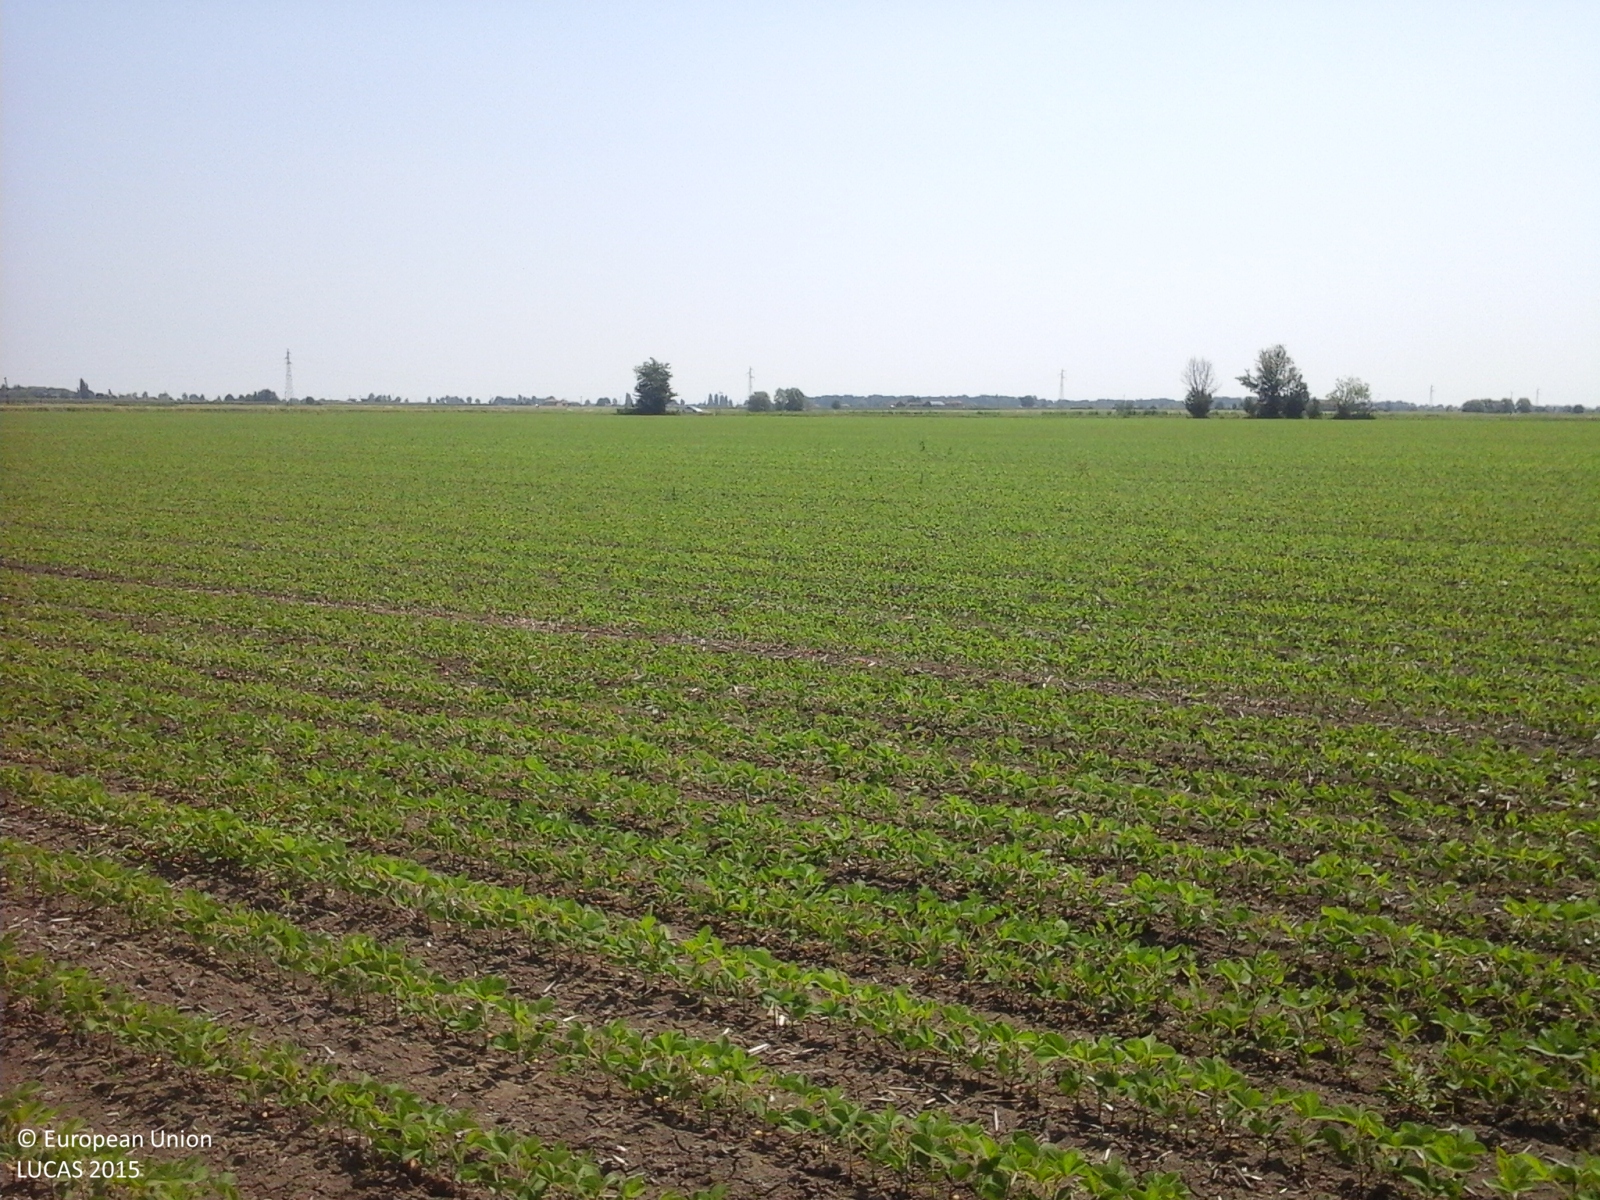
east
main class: Cropland
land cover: Soya
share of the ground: 10 - 25 %
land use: Agriculture (excluding fallow land and kitchen gardens)
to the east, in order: Soya; Ditches and canals; Soya; Ditches and canals; Soya
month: May
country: IT
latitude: 44.7695
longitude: 11.7024
